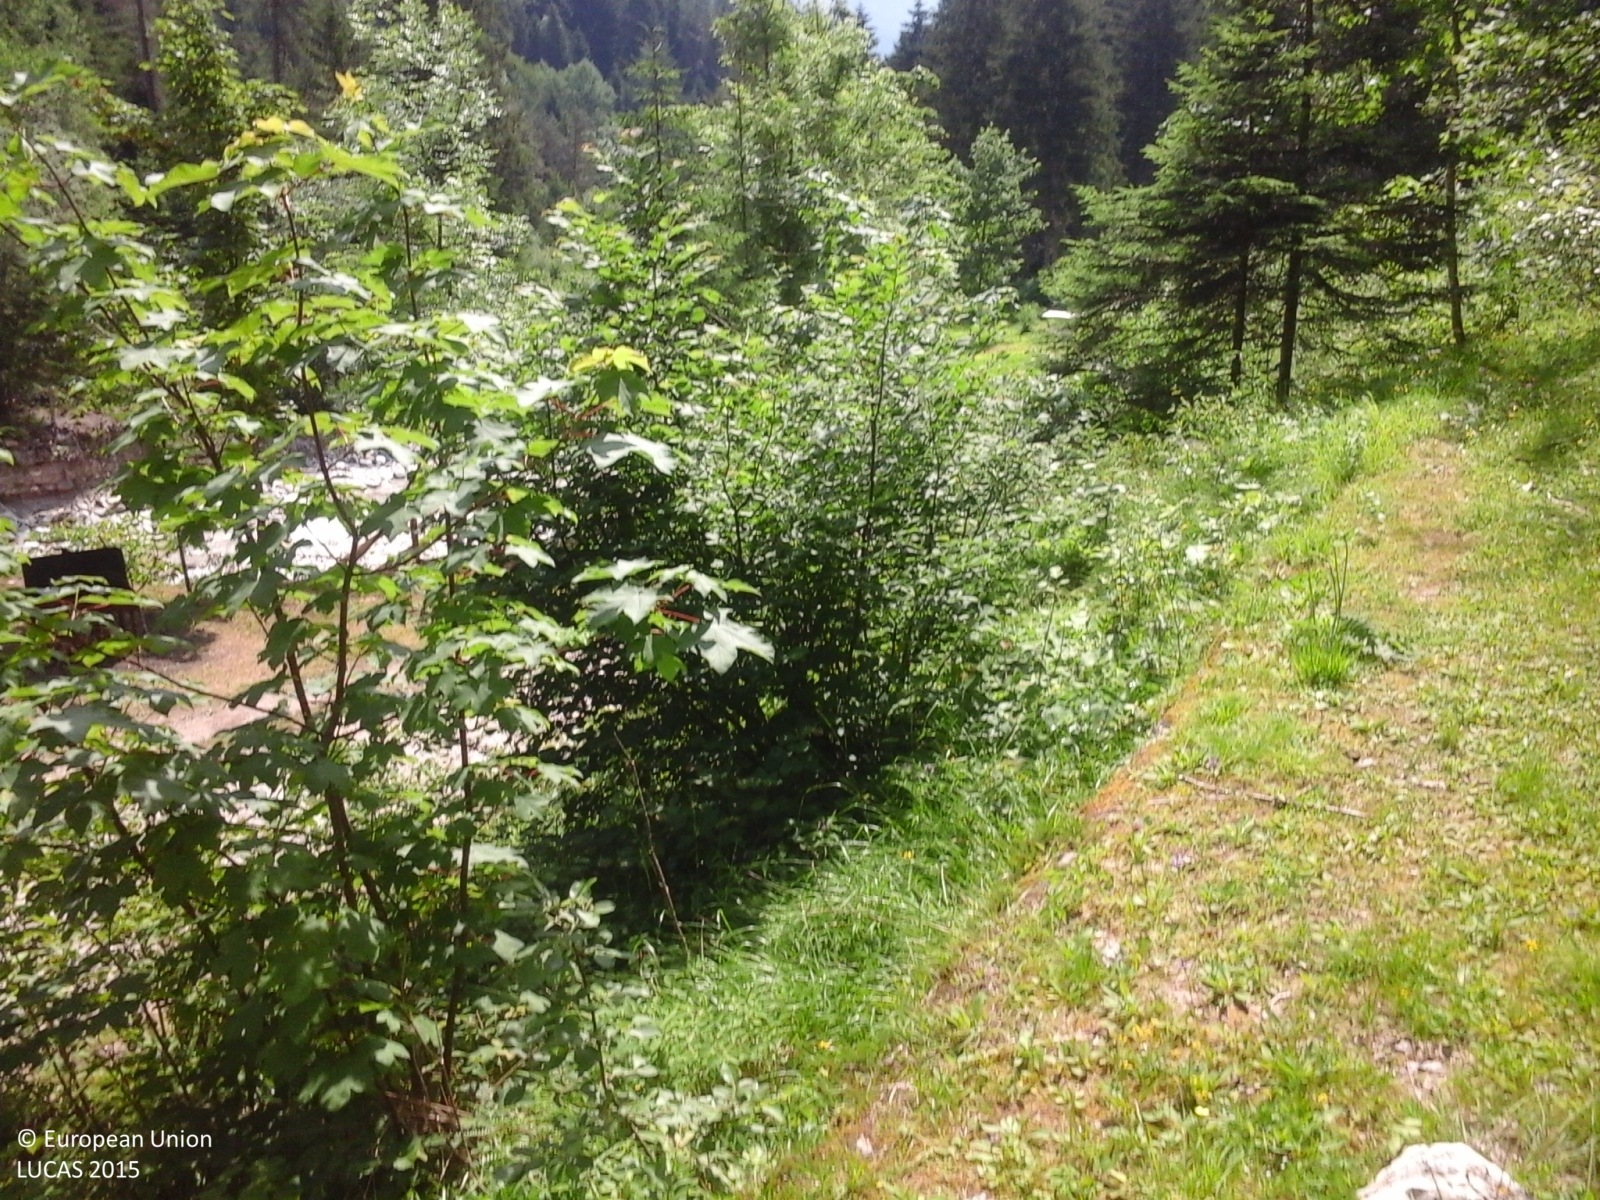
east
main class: Woodland
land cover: Spruce dominated mixed woodland
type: alpine coniferous forest
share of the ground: > 75 %
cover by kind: coniferous forest trees 75 %, broadleaved forest trees 25 %
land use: Semi-natural and natural areas not in use
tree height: > 5 m
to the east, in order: Spruce dominated mixed woodland; Shrubland with sparse tree cover; Tracks; Grassland without tree/shrub cover; Fences; Managed hedges; Inland fresh running water; Spruce dominated mixed woodland; Tracks; Grassland without tree/shrub cover; Tracks; Spruce dominated mixed woodland
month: June
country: IT
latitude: 46.4509
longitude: 12.3797
